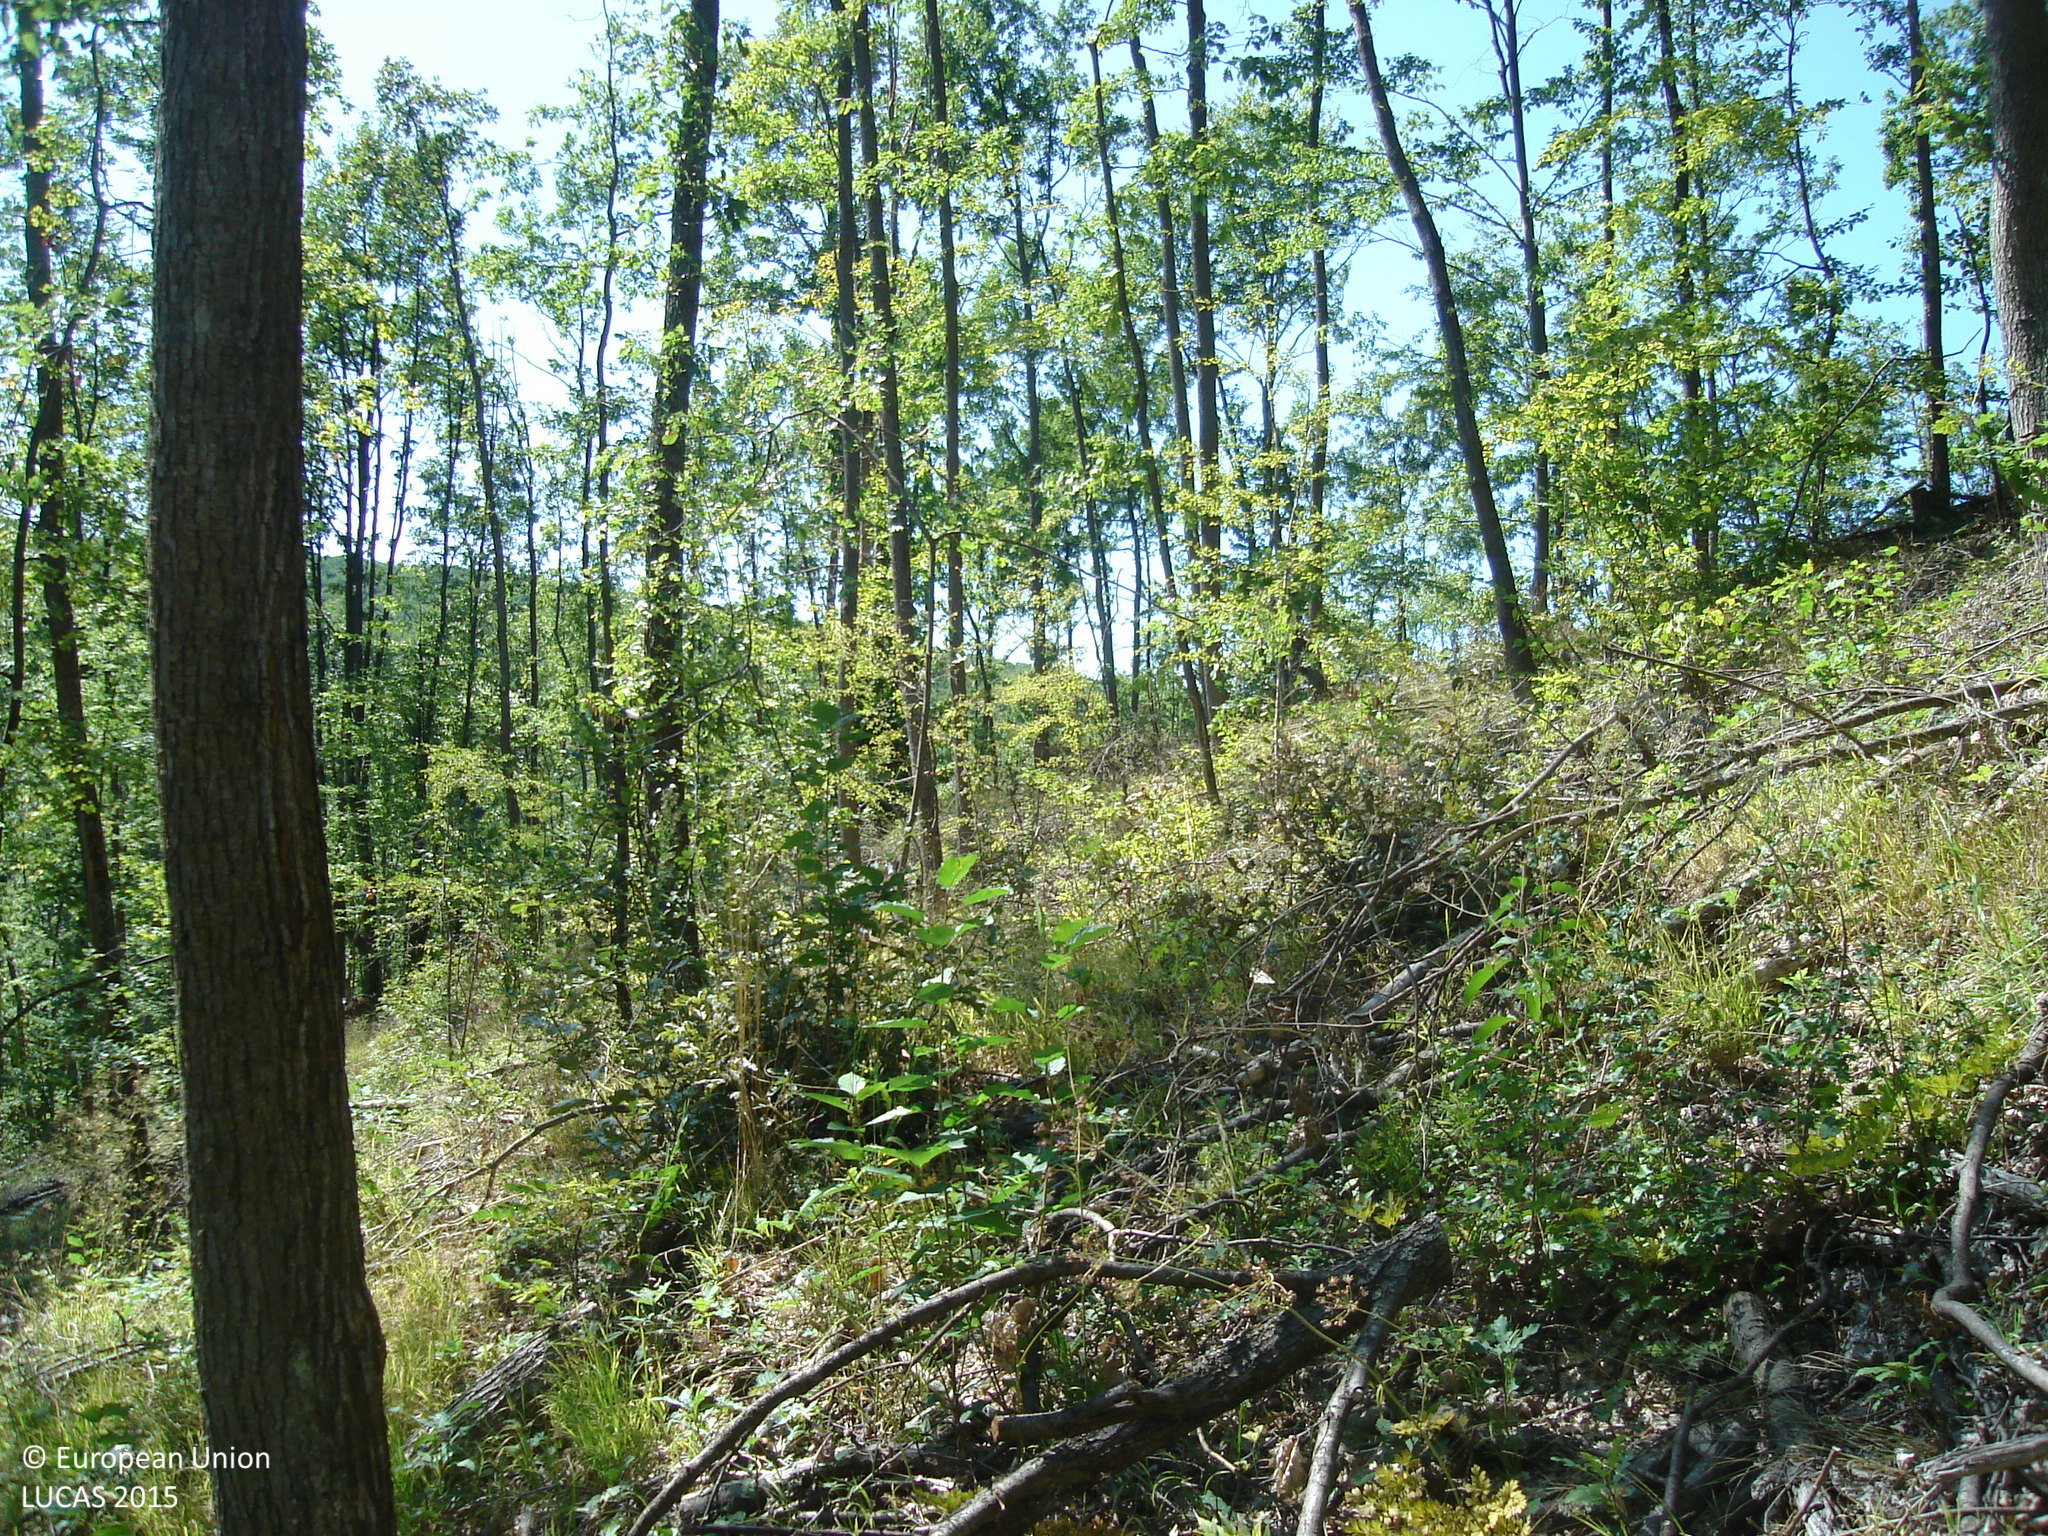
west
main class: Woodland
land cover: Broadleaved woodland
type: mesophytic deciduous forest
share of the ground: > 75 %
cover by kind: broadleaved forest trees 80 %, herbaceous plants 15 %, shrubs 5 %
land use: Forestry
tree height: > 5 m
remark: Clear cut
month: September
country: BG
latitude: 42.5053
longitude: 23.8281
